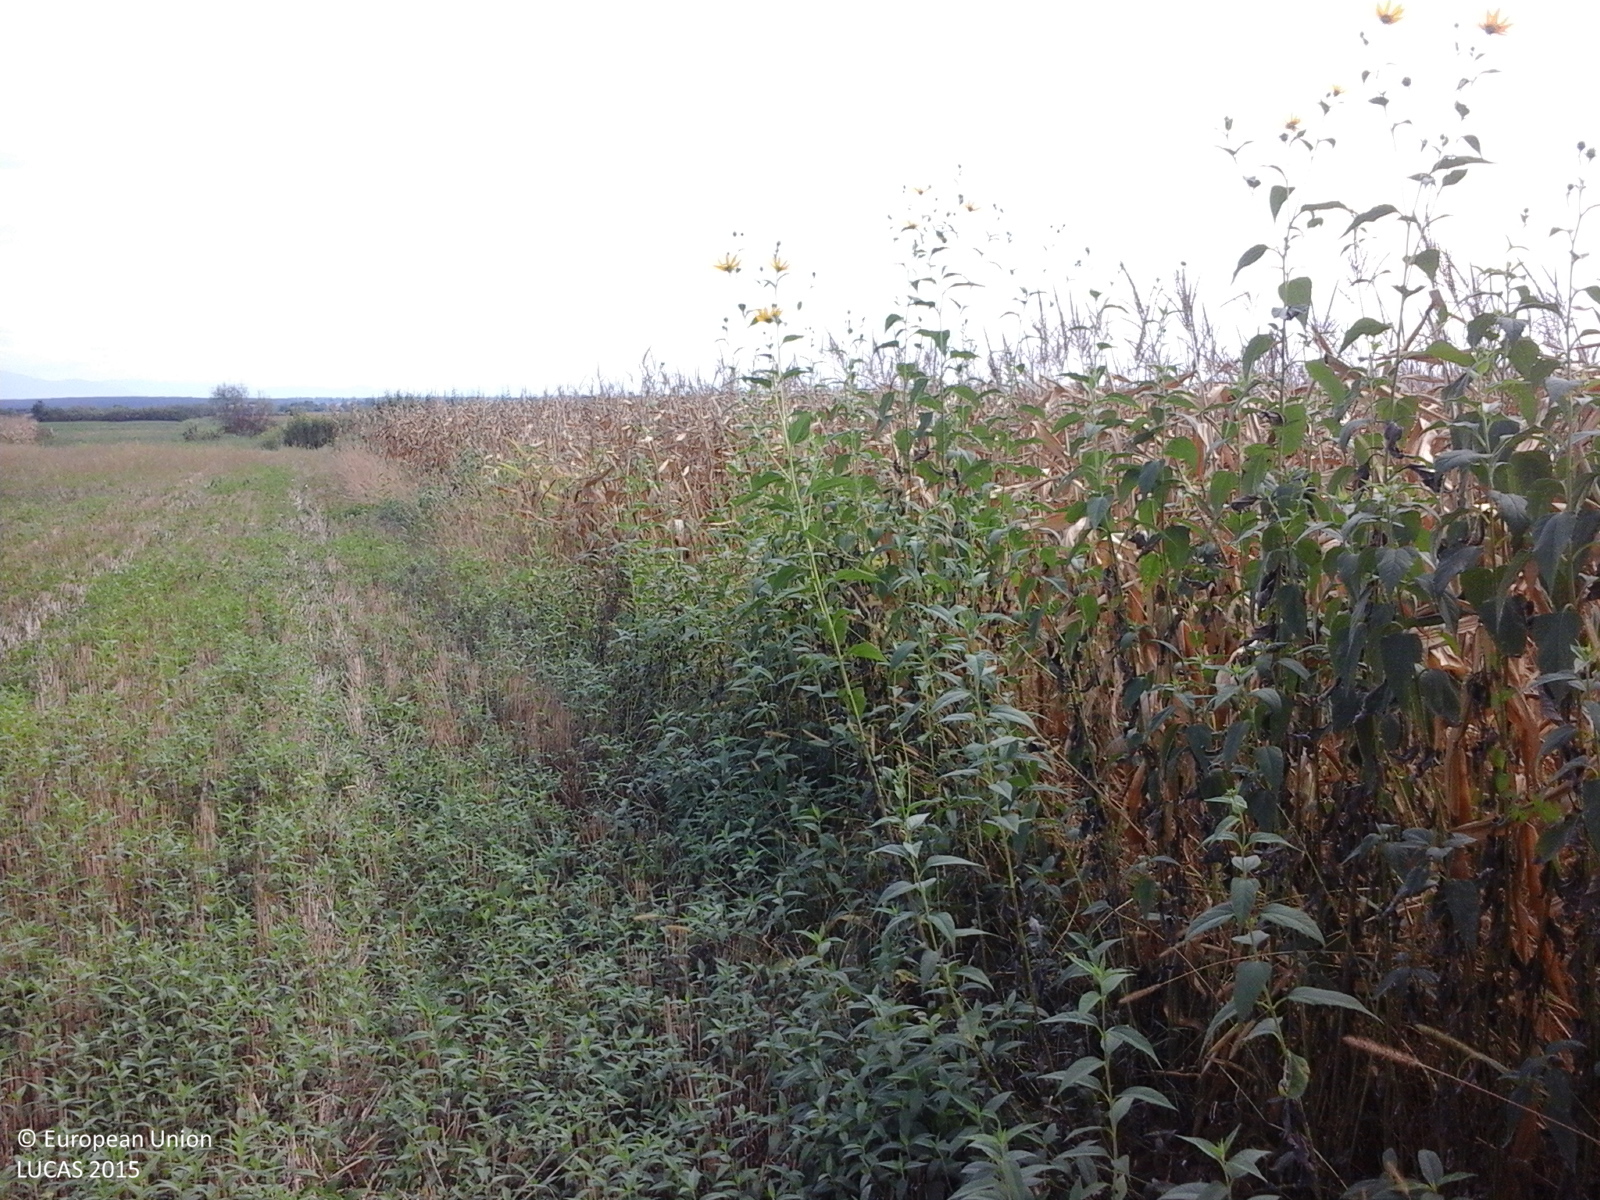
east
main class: Cropland
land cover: Maize
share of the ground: > 75 %
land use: Agriculture (excluding fallow land and kitchen gardens)
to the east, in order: Maize; Grass margins; Tracks; Grass margins; Potatoes
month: September
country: RO
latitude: 47.5036
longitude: 23.3067
